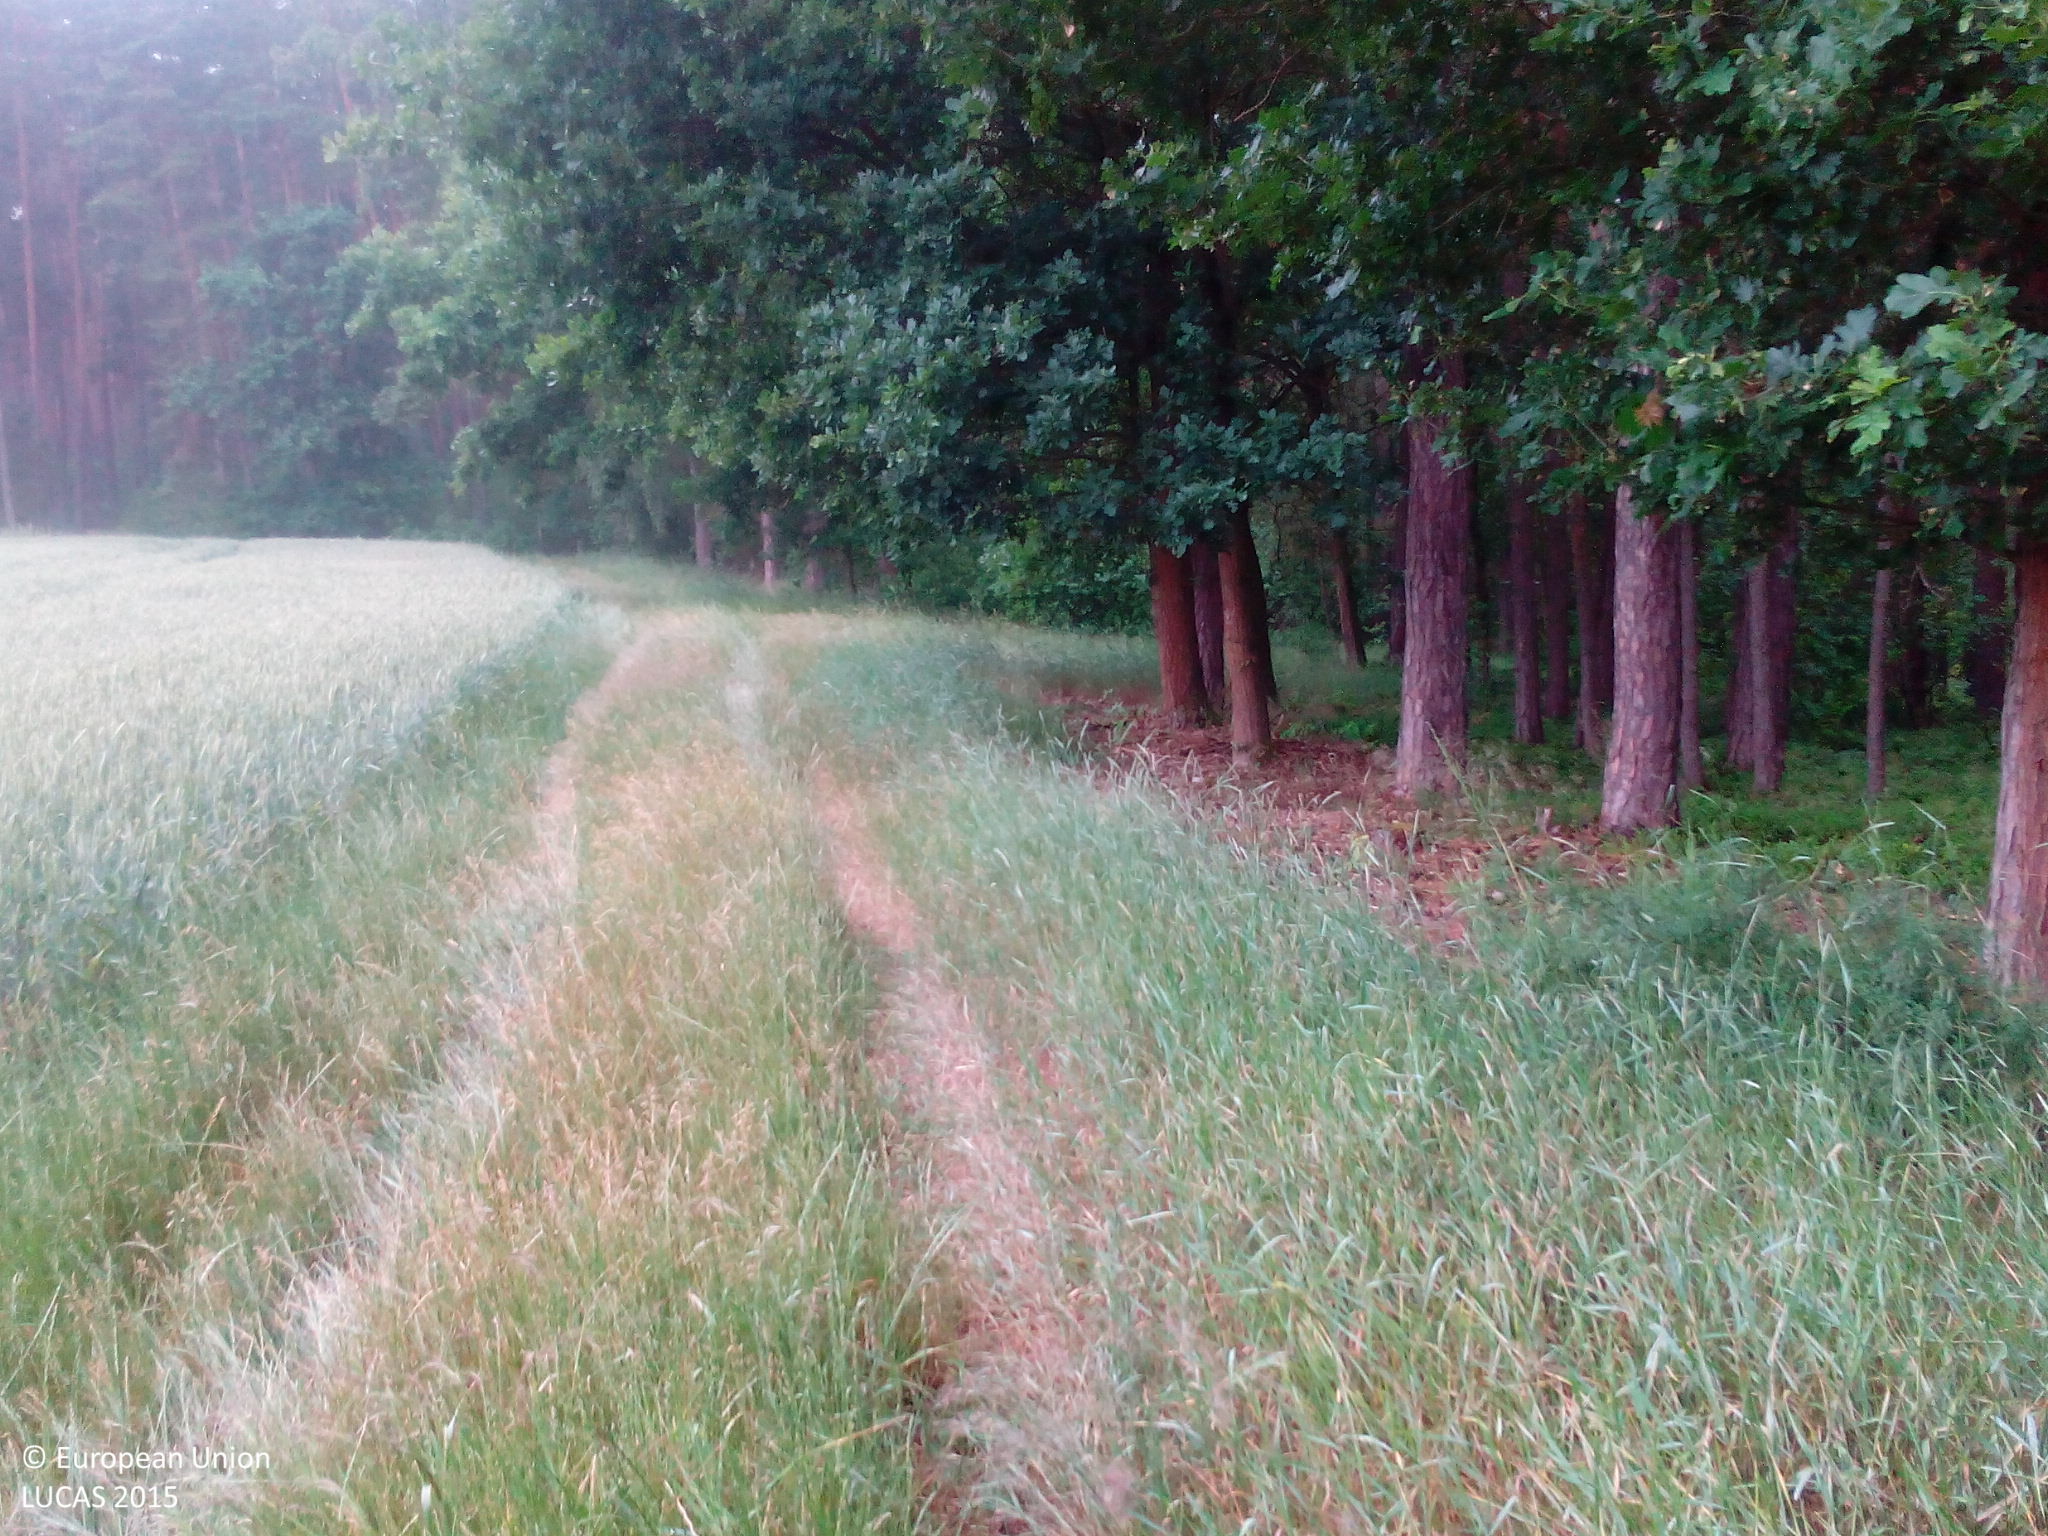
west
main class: Woodland
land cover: Pine dominated coniferous woodland
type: hemiboreal forest and nemoral coniferous forest and mixed broadleaved-coniferous forest
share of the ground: > 75 %
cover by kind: coniferous forest trees 75 %, herbaceous plants 20 %, broadleaved forest trees 5 %
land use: Forestry
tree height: > 5 m
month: June
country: DE
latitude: 49.2814
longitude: 10.8932
